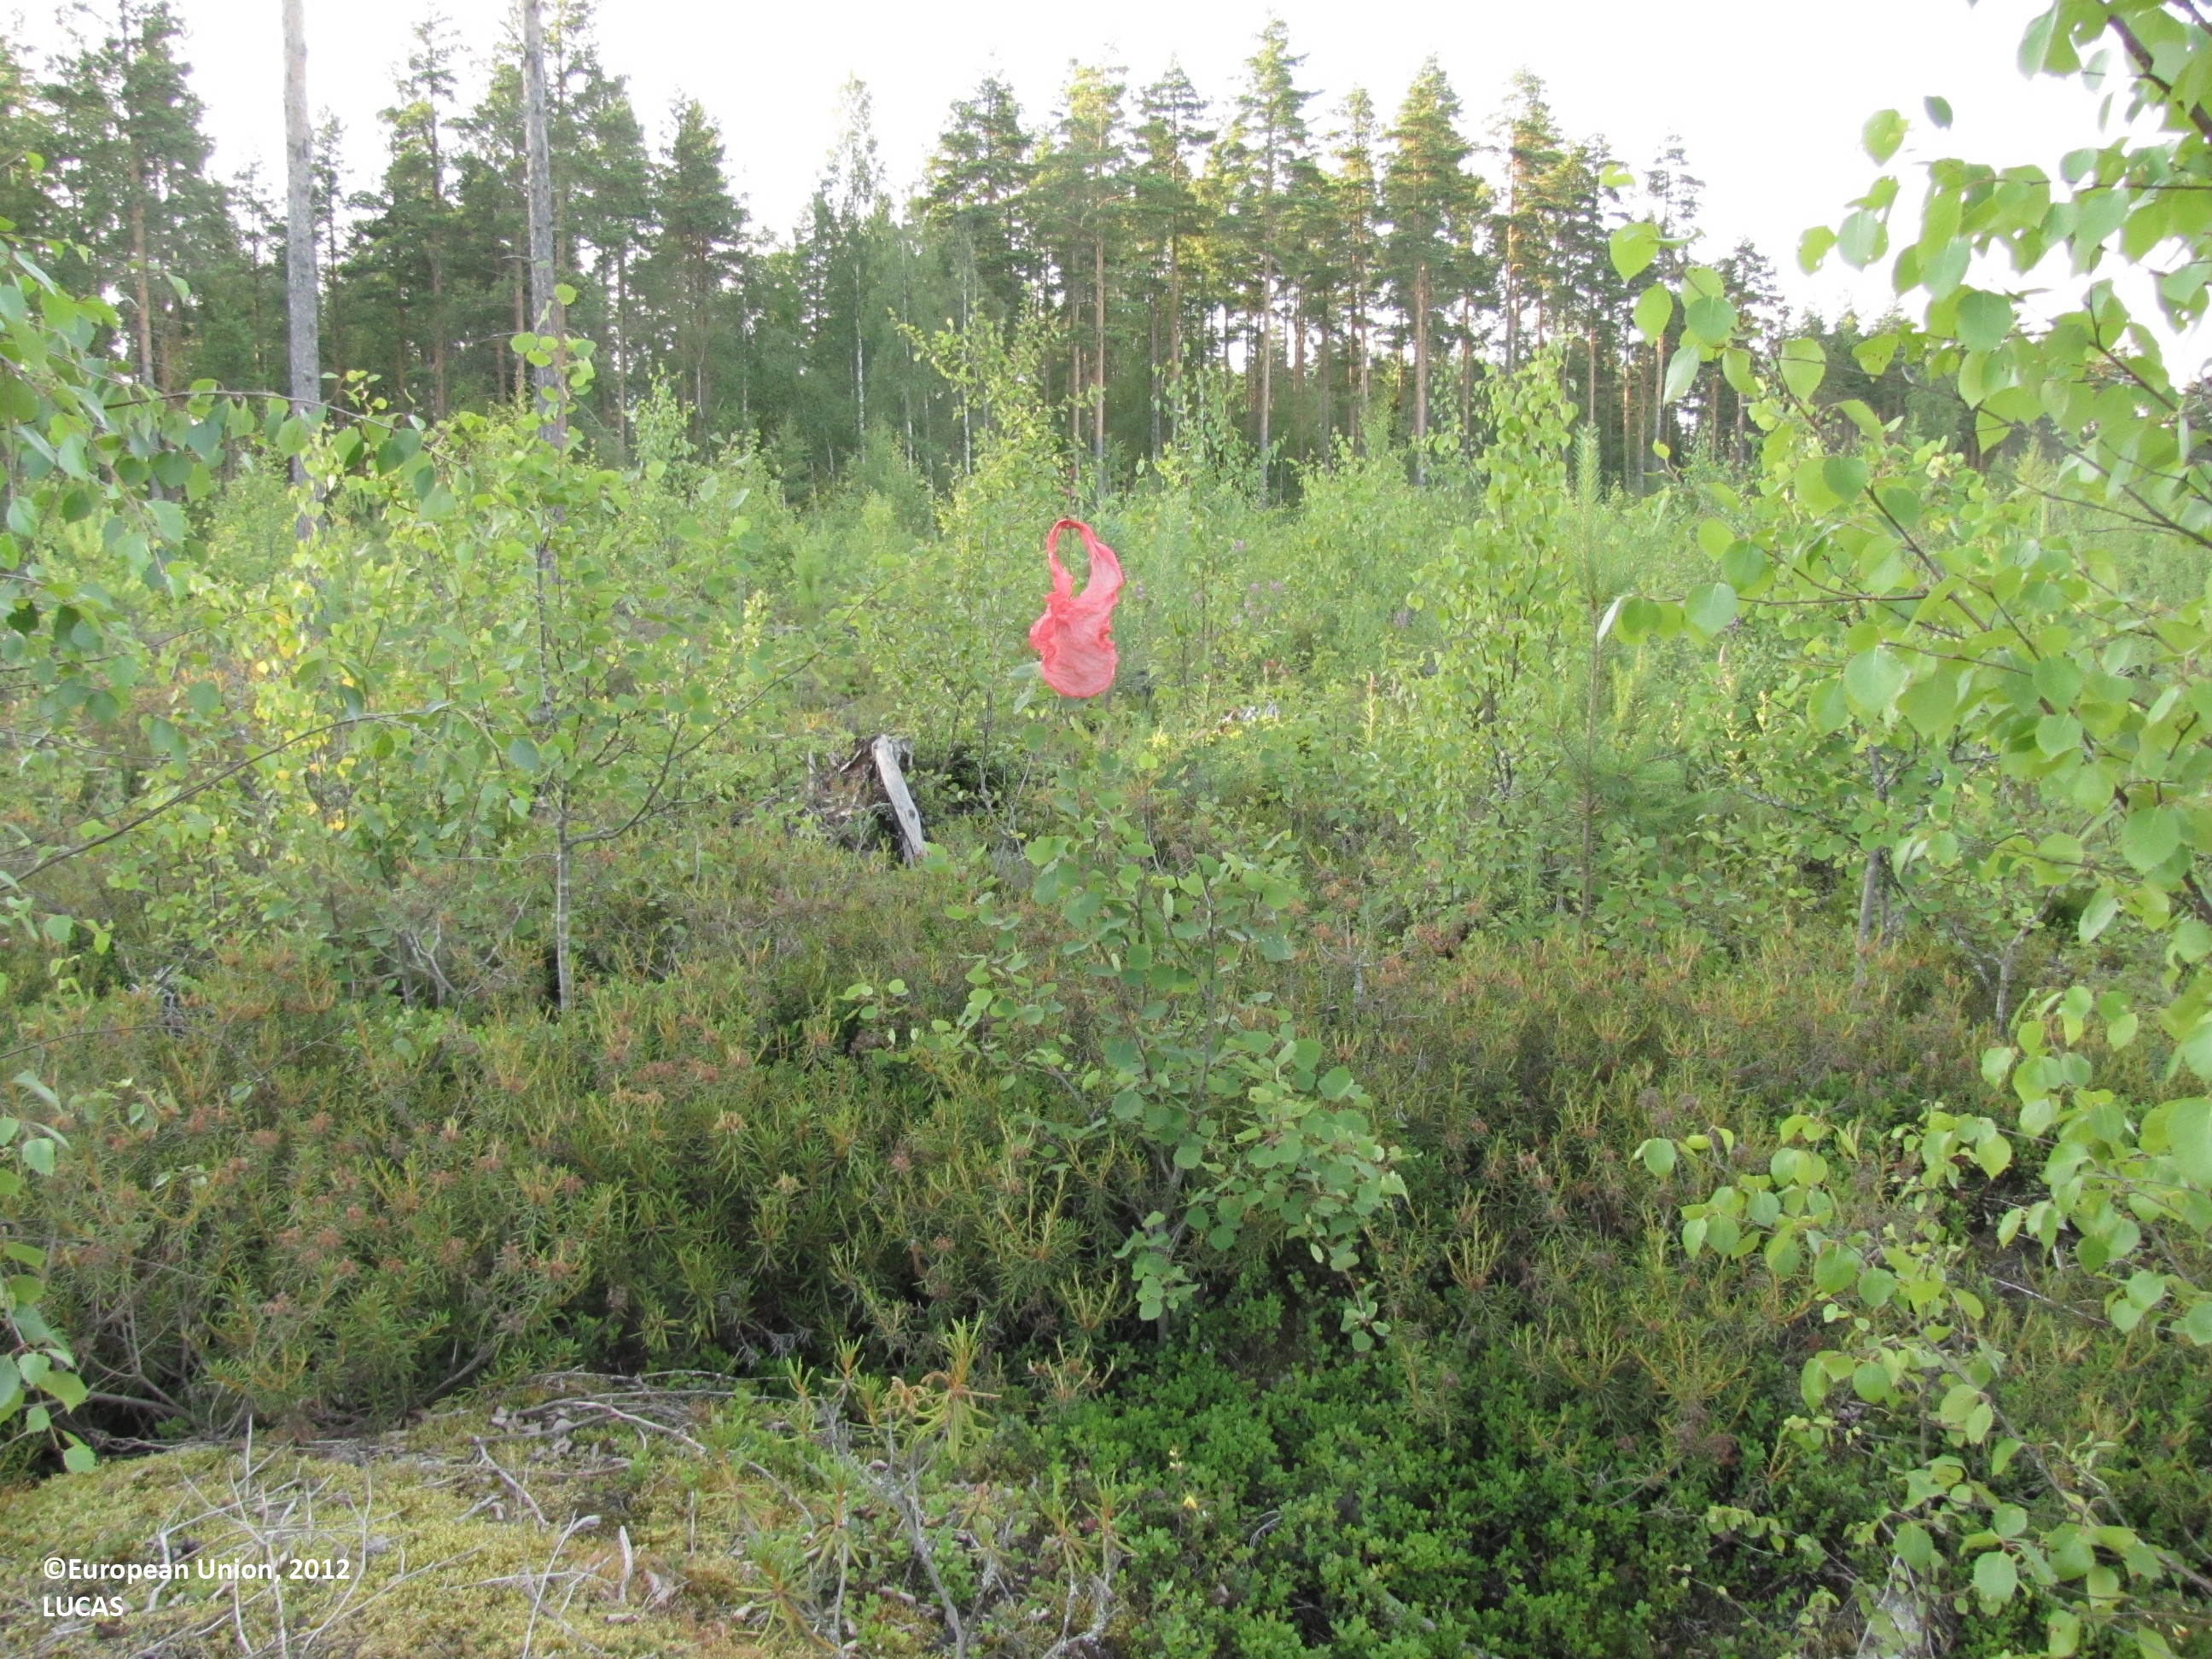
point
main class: Woodland
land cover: Broadleaved woodland
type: mire and swamp forests
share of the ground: 50 - 75 %
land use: Forestry
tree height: < 5 m
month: July
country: FI
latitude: 62.5675
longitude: 23.3174
